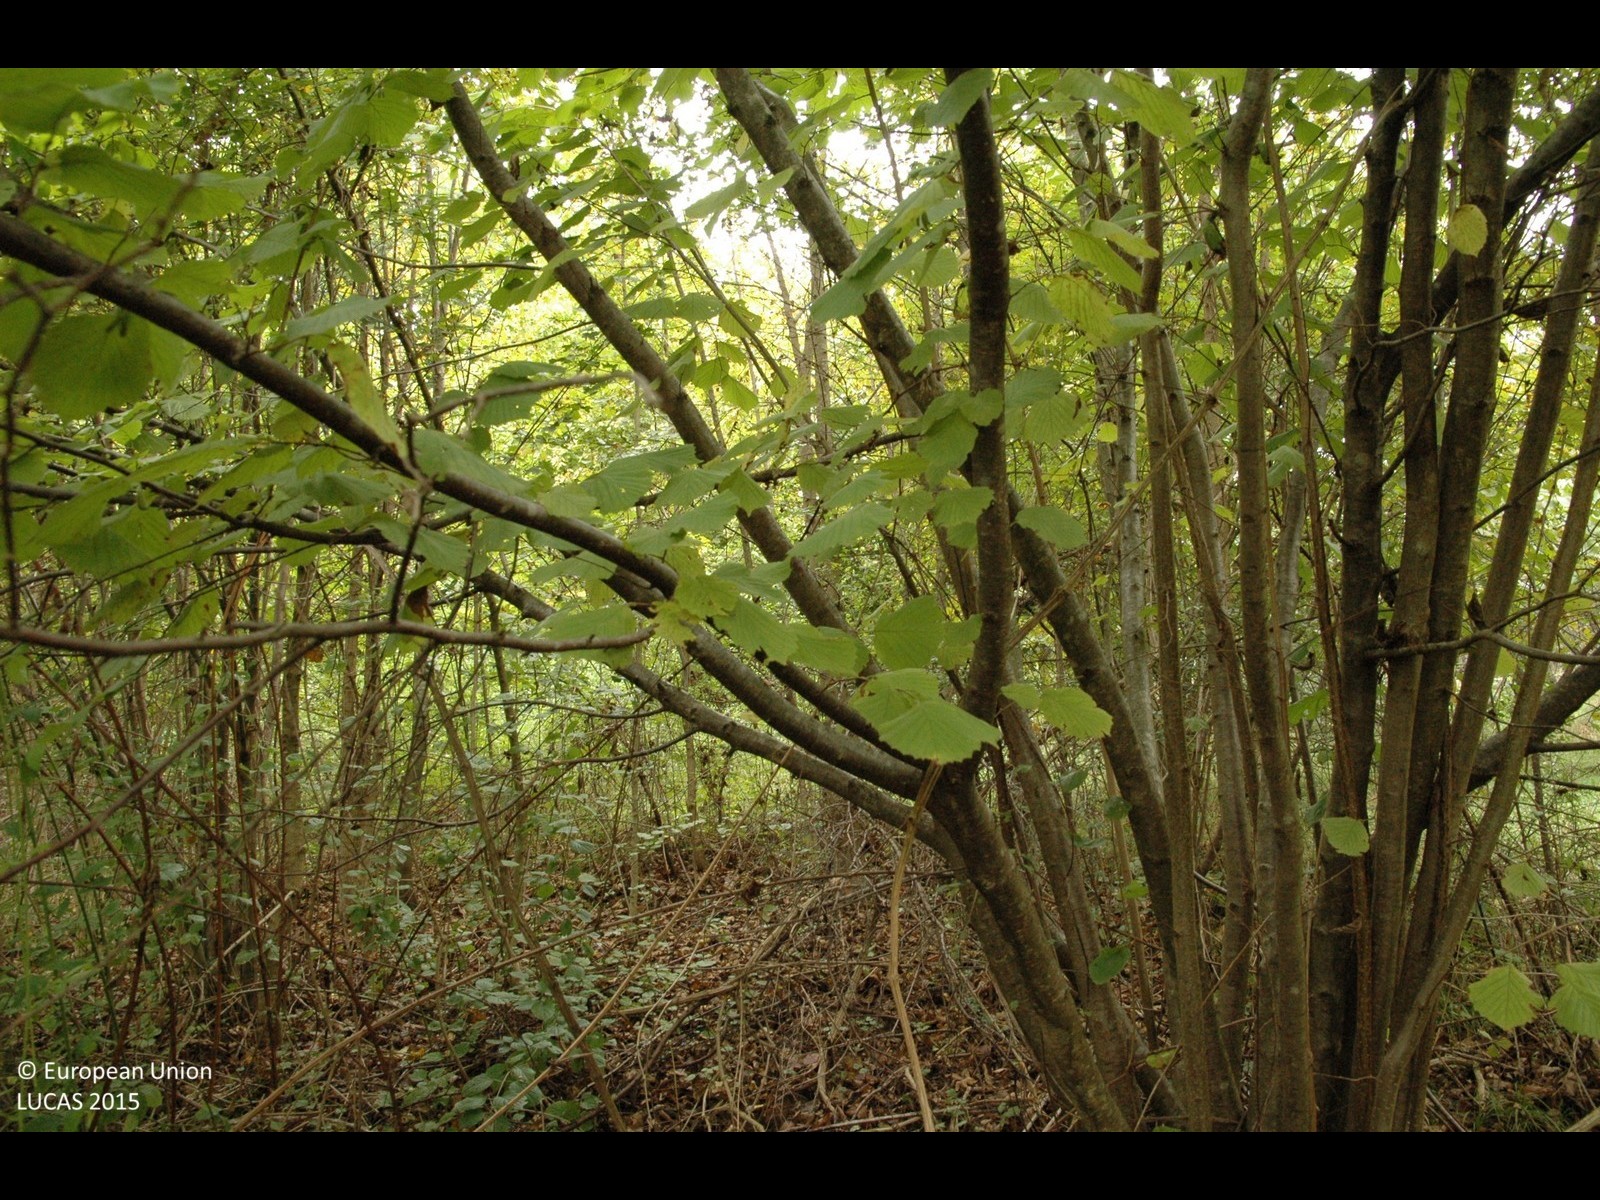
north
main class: Shrubland
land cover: Shrubland with sparse tree cover
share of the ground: > 75 %
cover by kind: shrubs 80 %, herbaceous plants 15 %, broadleaved forest trees 5 %
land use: Semi-natural and natural areas not in use
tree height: > 5 m
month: September
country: HR
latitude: 45.2466
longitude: 15.6143
